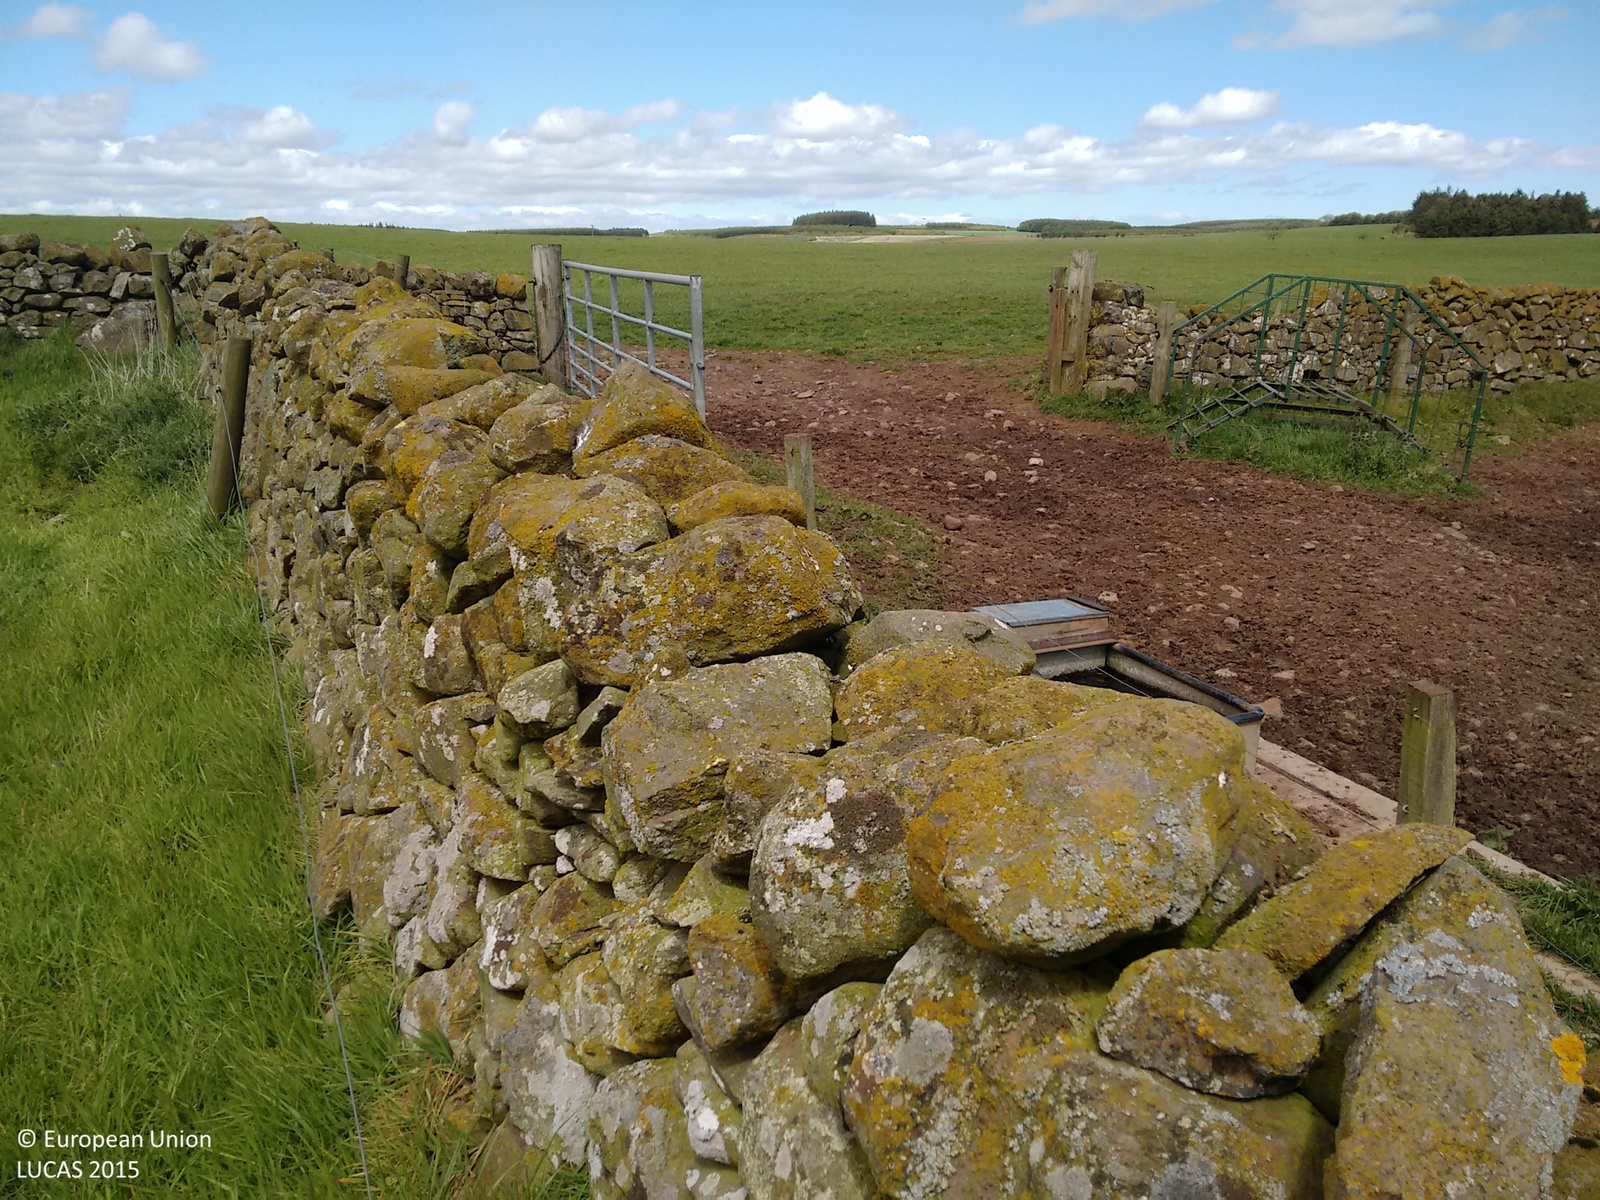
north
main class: Grassland
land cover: Grassland without tree/shrub cover
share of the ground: > 75 %
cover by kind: herbaceous plants 100 %
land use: Agriculture (excluding fallow land and kitchen gardens)
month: June
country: GB
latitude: 55.7023
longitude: -2.4877
